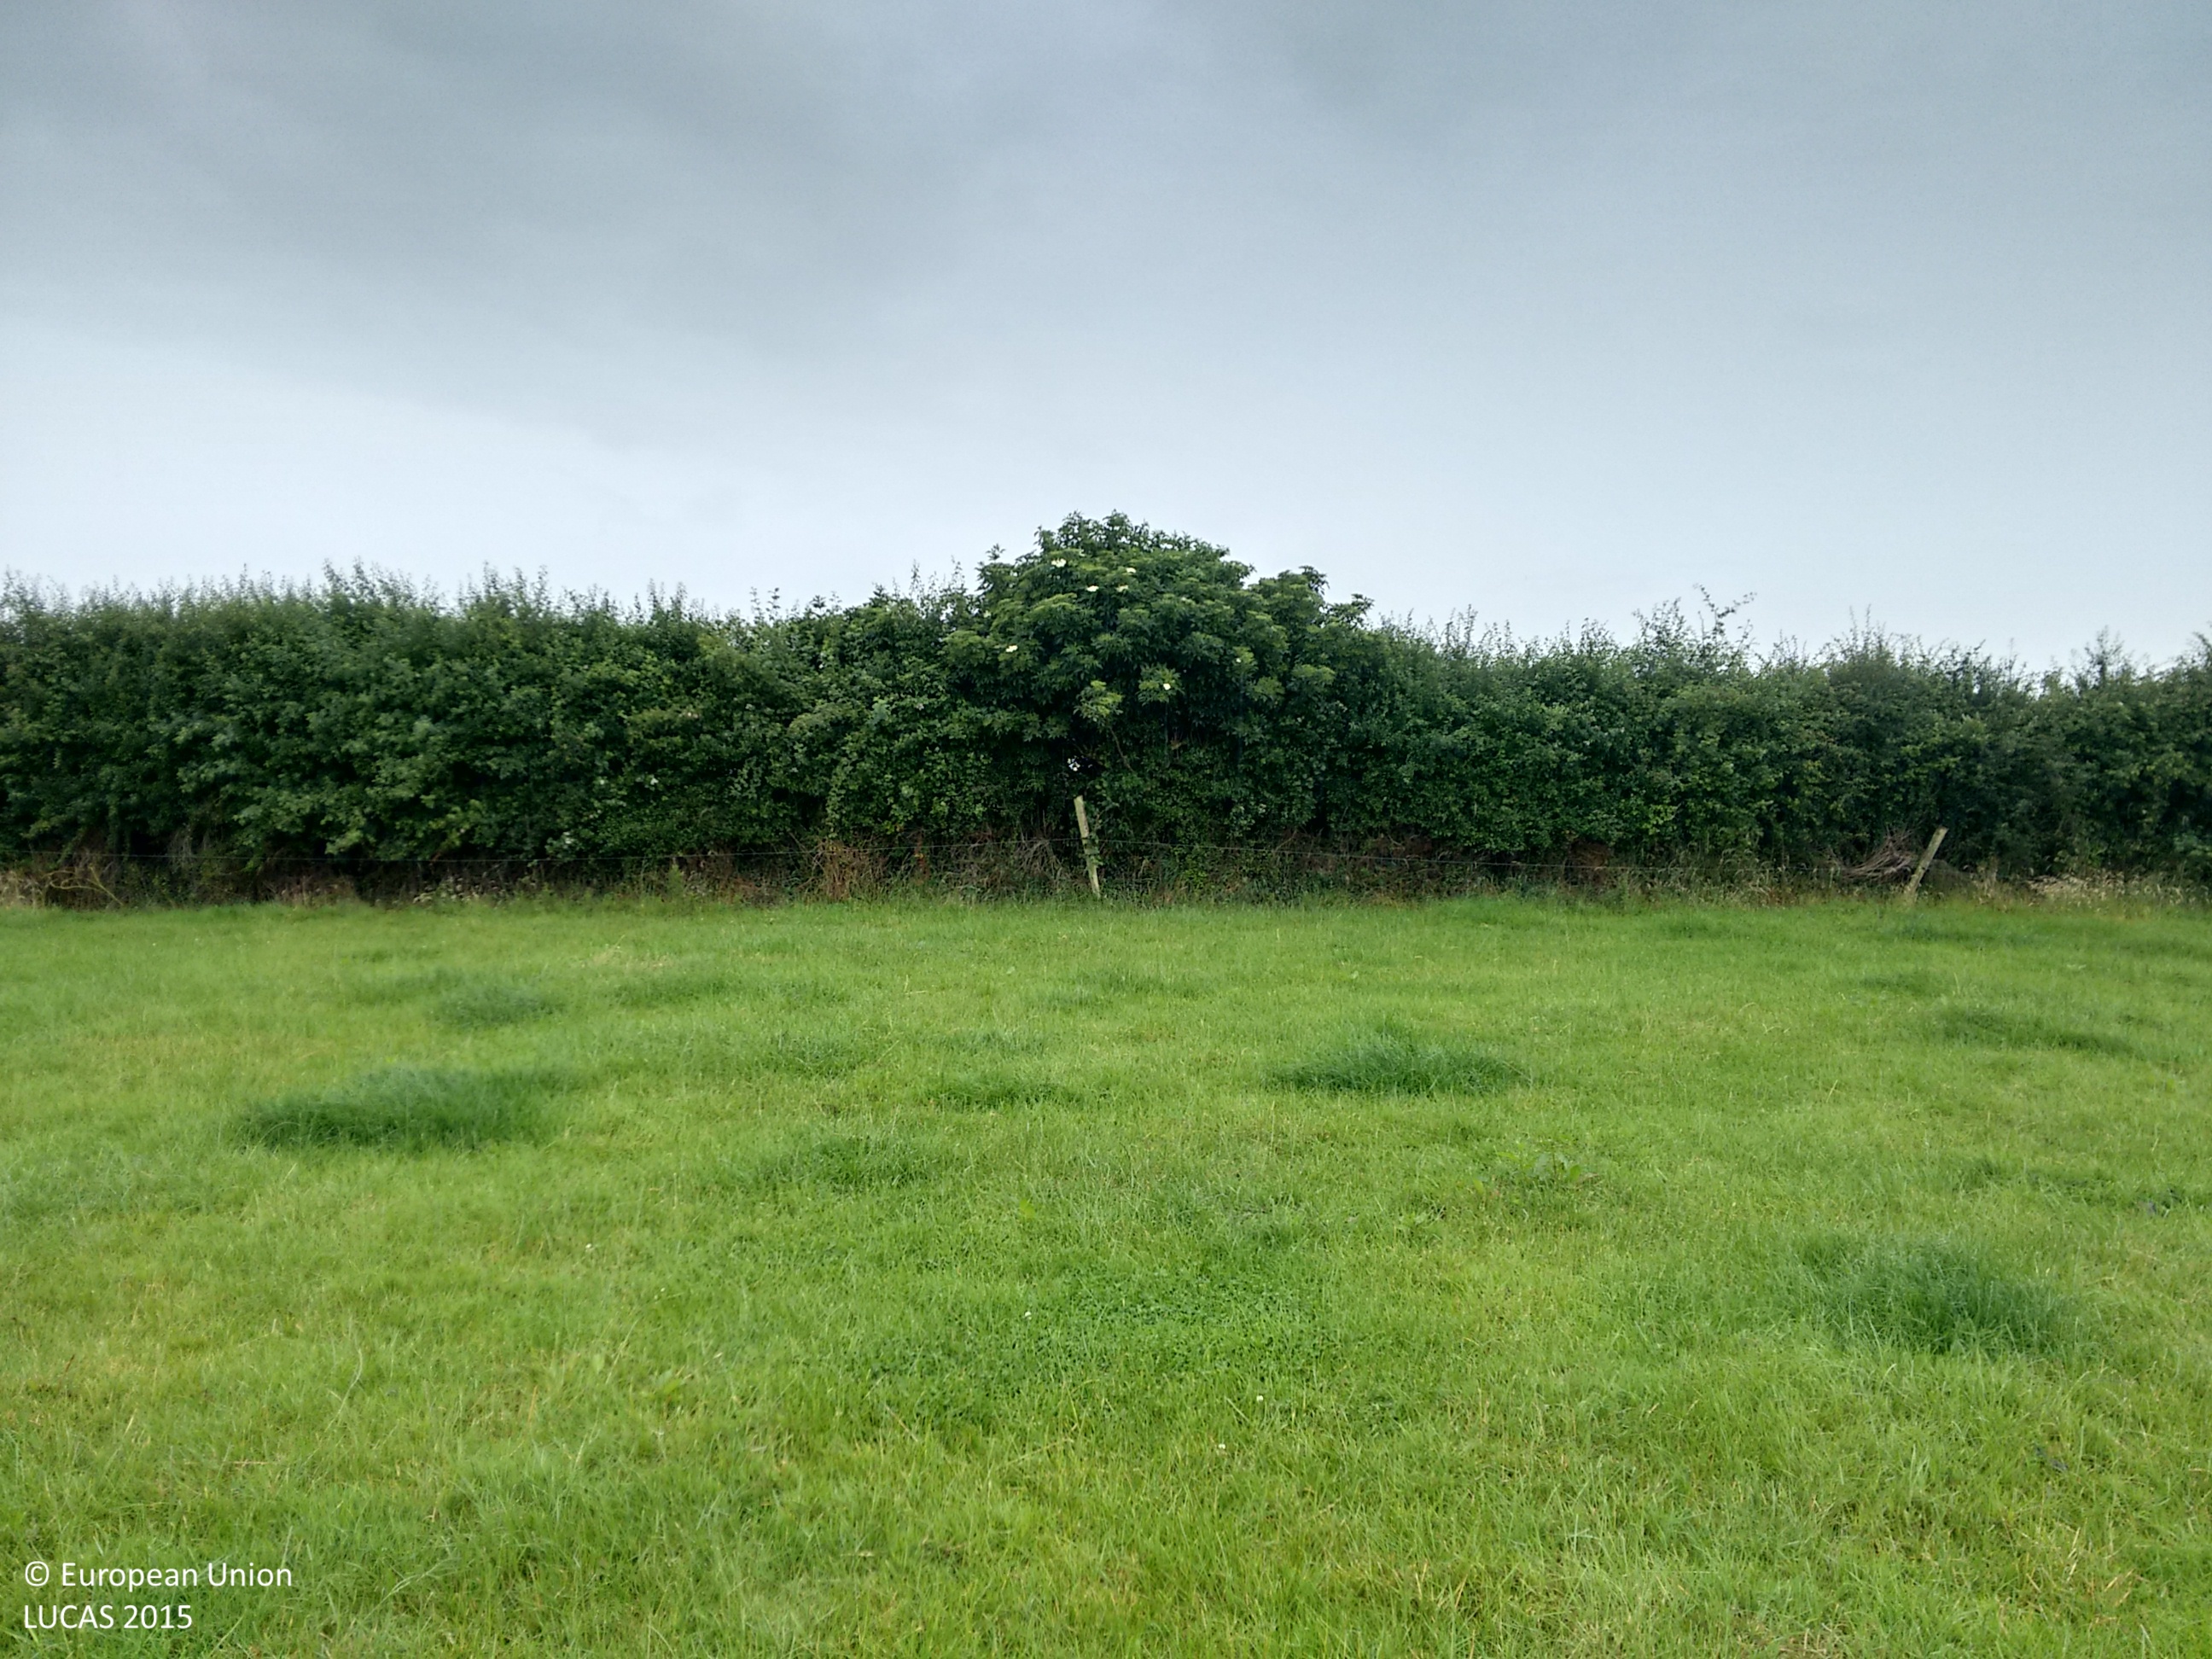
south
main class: Grassland
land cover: Grassland without tree/shrub cover
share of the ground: > 75 %
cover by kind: herbaceous plants 100 %
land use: Agriculture (excluding fallow land and kitchen gardens)
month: July
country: IE
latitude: 52.5947
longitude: -7.2304
